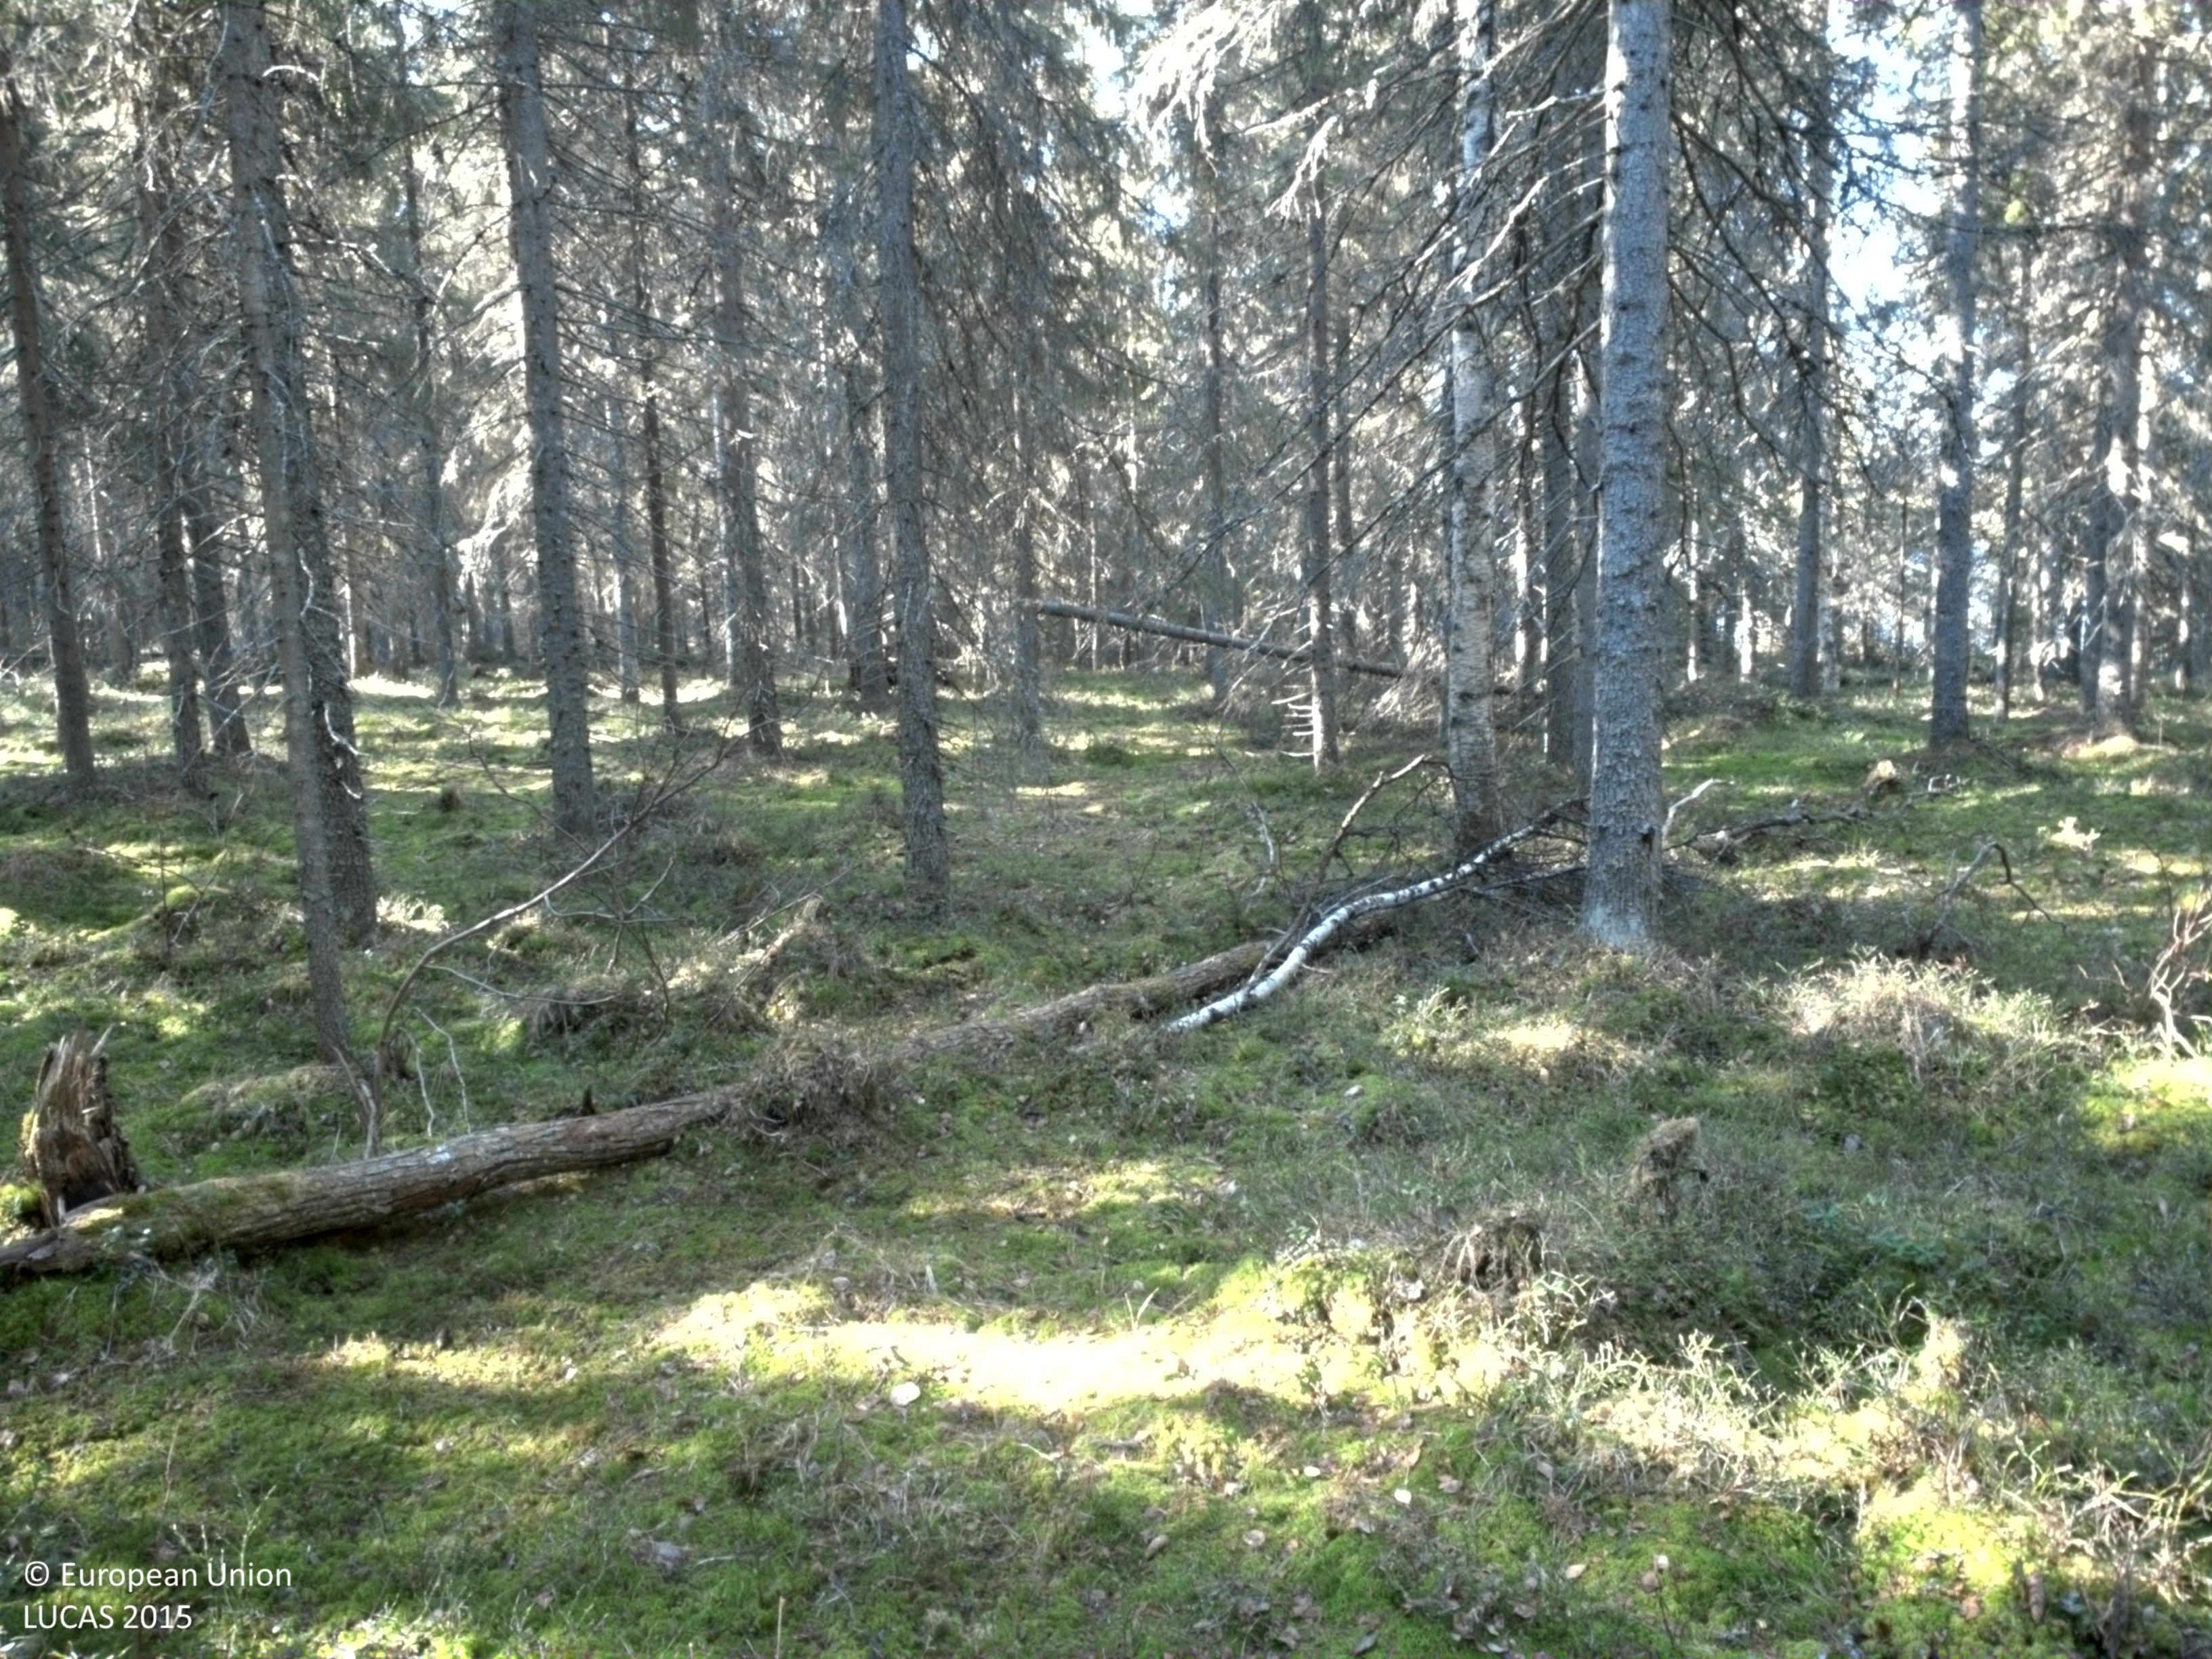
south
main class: Woodland
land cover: Spruce dominated coniferous woodland
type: boreal forest
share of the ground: > 75 %
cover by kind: coniferous forest trees 75 %, lichens and mosses 15 %, shrubs 10 %
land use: Forestry
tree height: > 5 m
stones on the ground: < 10 %
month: May
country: SE
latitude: 65.8797
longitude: 23.2569
